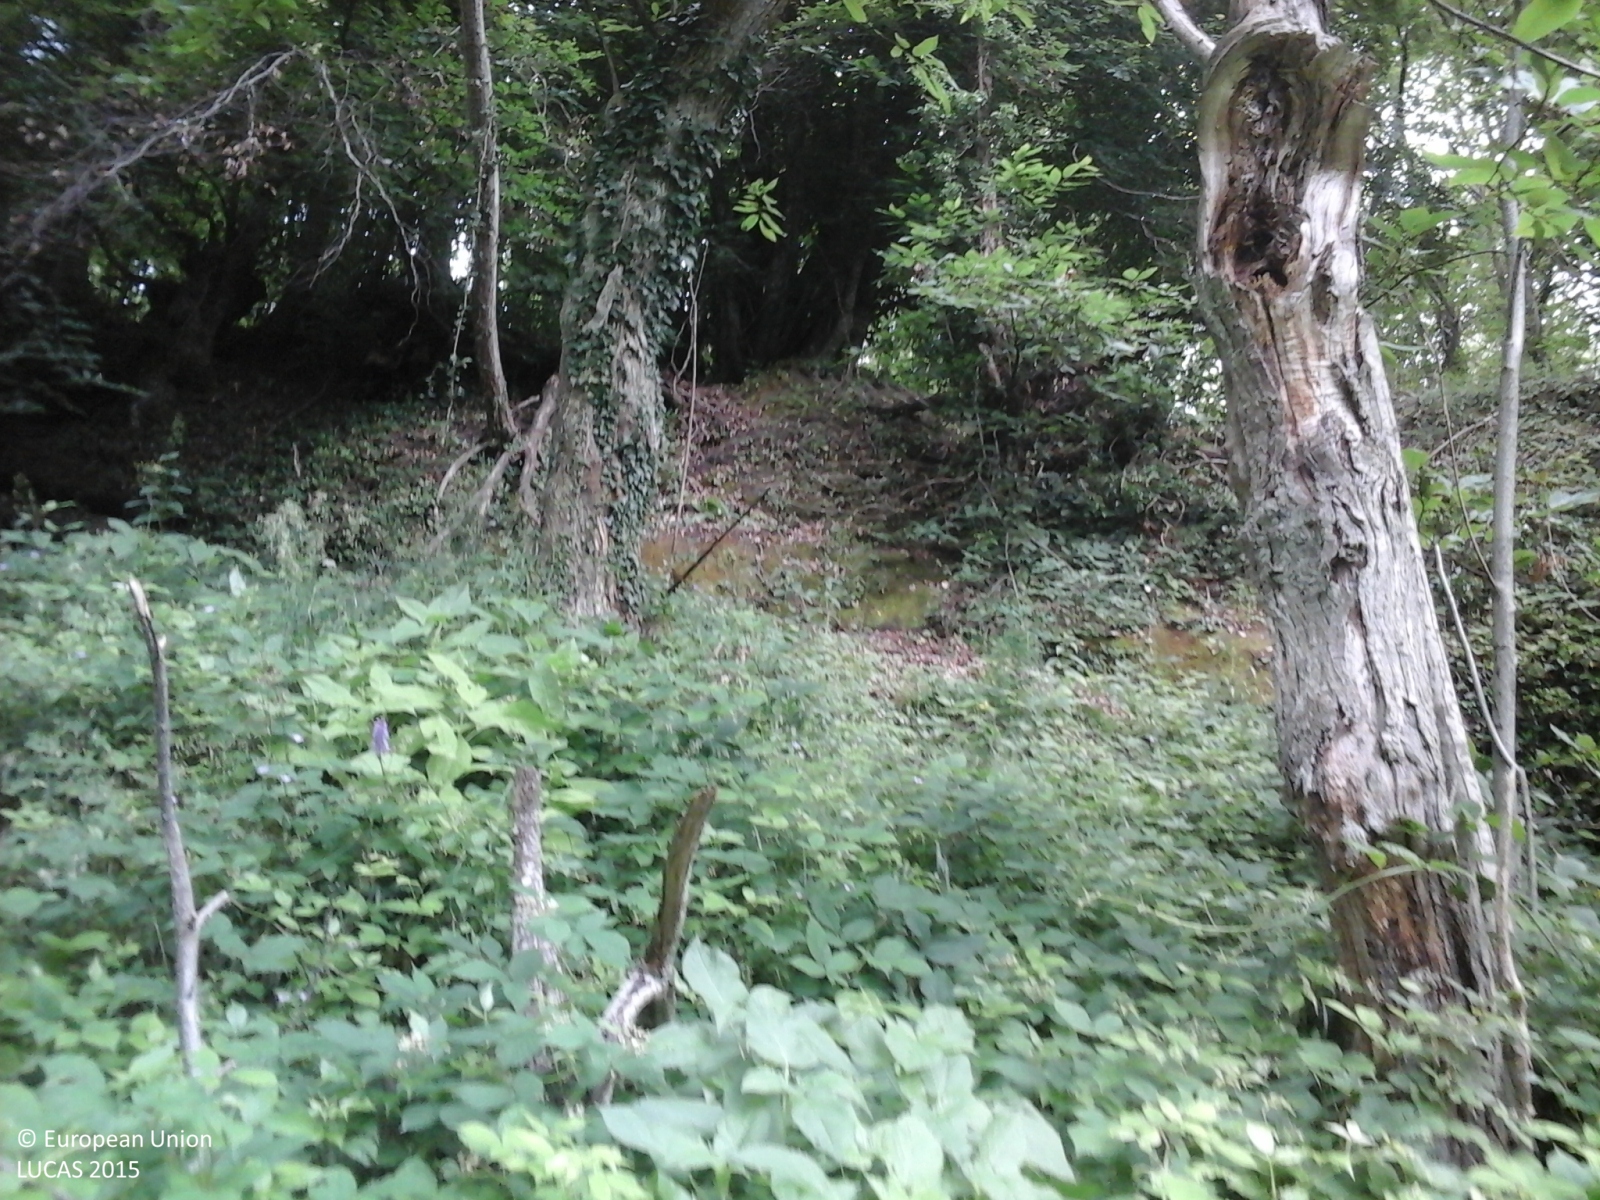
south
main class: Woodland
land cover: Broadleaved woodland
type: thermophilous deciduous forest
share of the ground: > 75 %
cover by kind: broadleaved forest trees 100 %
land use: Forestry
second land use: Other primary production
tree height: > 5 m
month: June
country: IT
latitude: 42.8334
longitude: 13.3546
